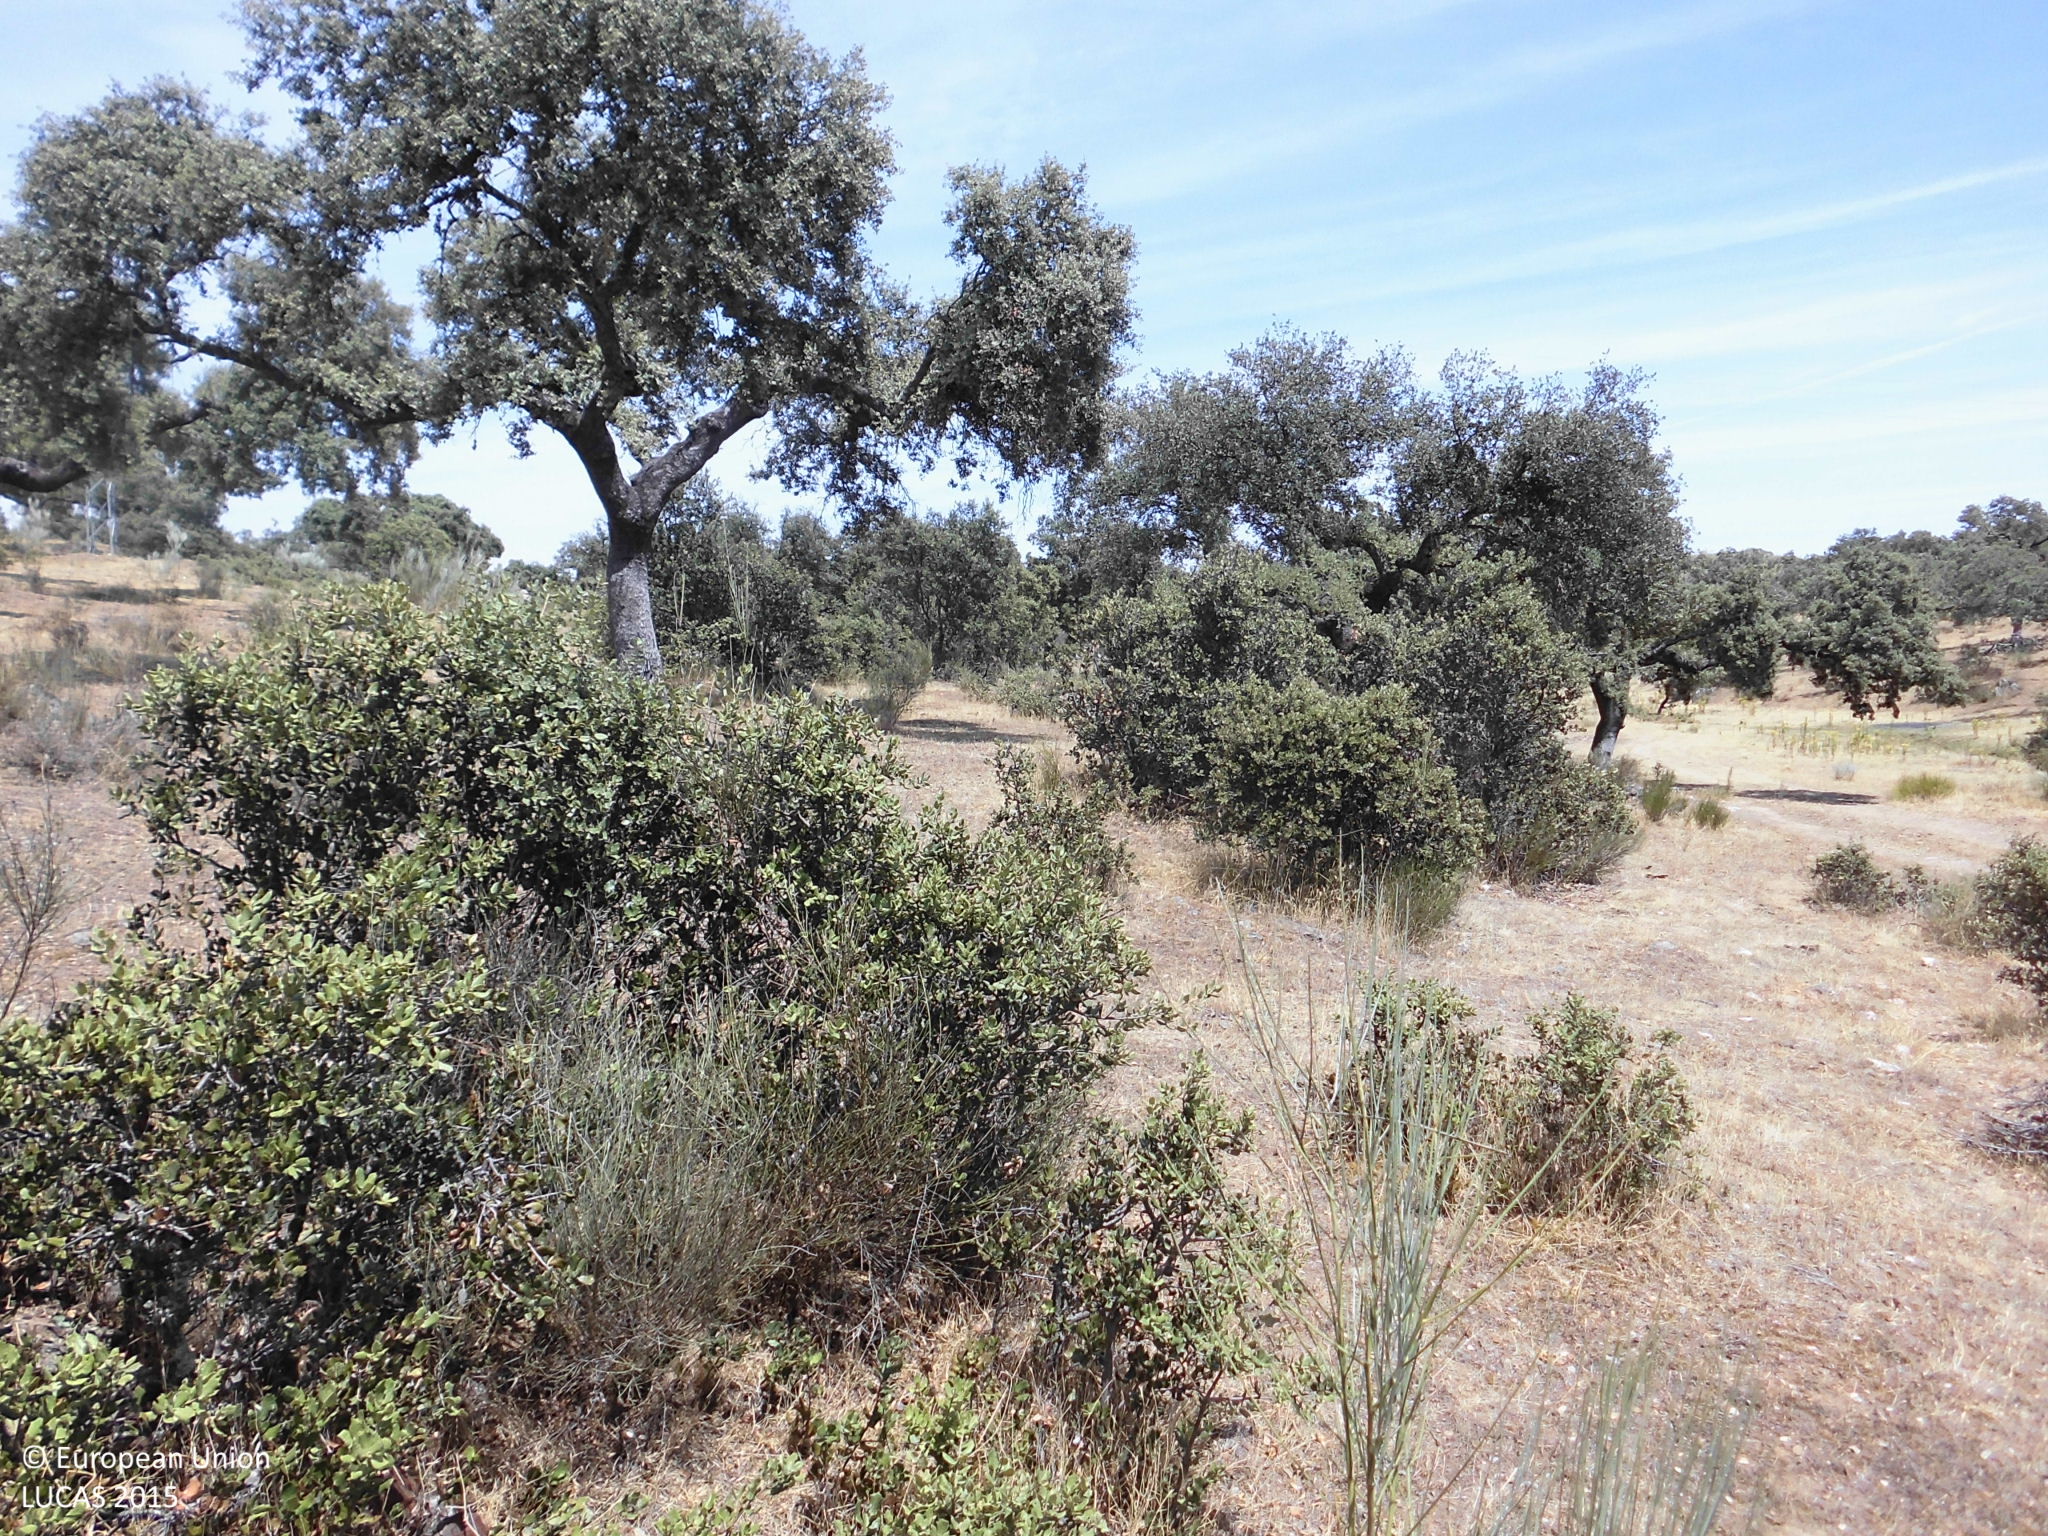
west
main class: Woodland
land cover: Broadleaved woodland
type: broadleaved evergreen forest
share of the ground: 10 - 25 %
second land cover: Grassland without tree/shrub cover
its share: > 75 %
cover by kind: herbaceous plants 85 %, broadleaved forest trees 15 %
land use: Forestry
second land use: Agriculture (excluding fallow land and kitchen gardens)
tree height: > 5 m
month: July
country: ES
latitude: 39.9032
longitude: -6.5360
